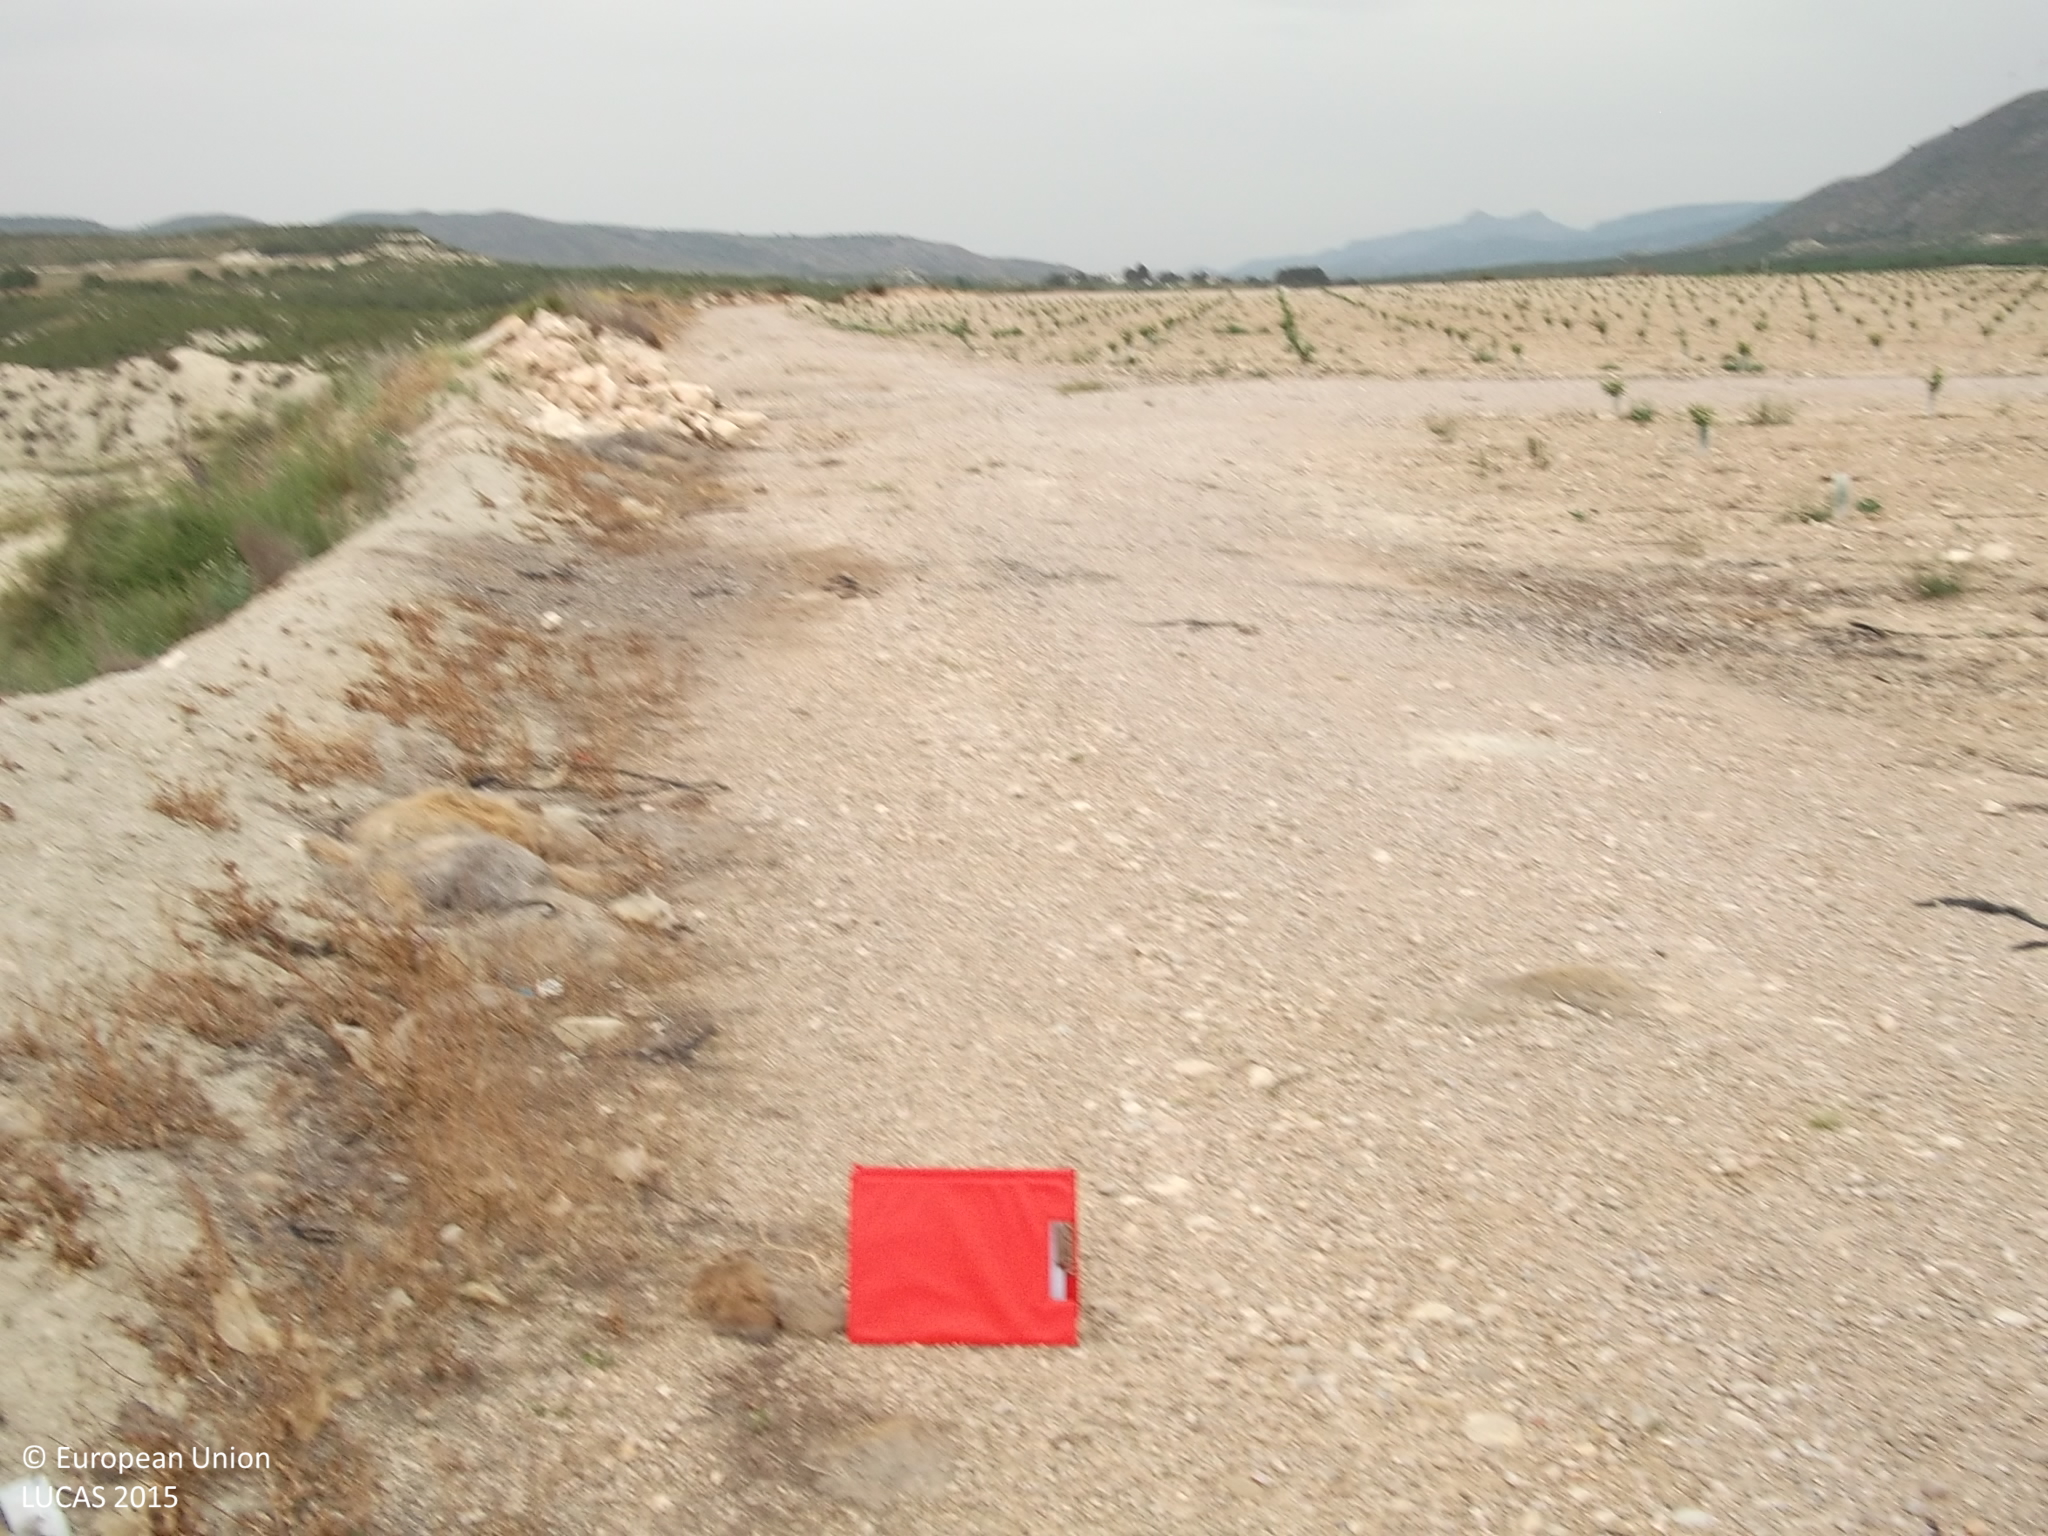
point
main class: Cropland
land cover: Other fruit trees and berries
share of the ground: < 10 %
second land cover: Other bare soil
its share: > 75 %
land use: Agriculture (excluding fallow land and kitchen gardens)
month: May
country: ES
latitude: 38.2840
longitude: -1.4097
